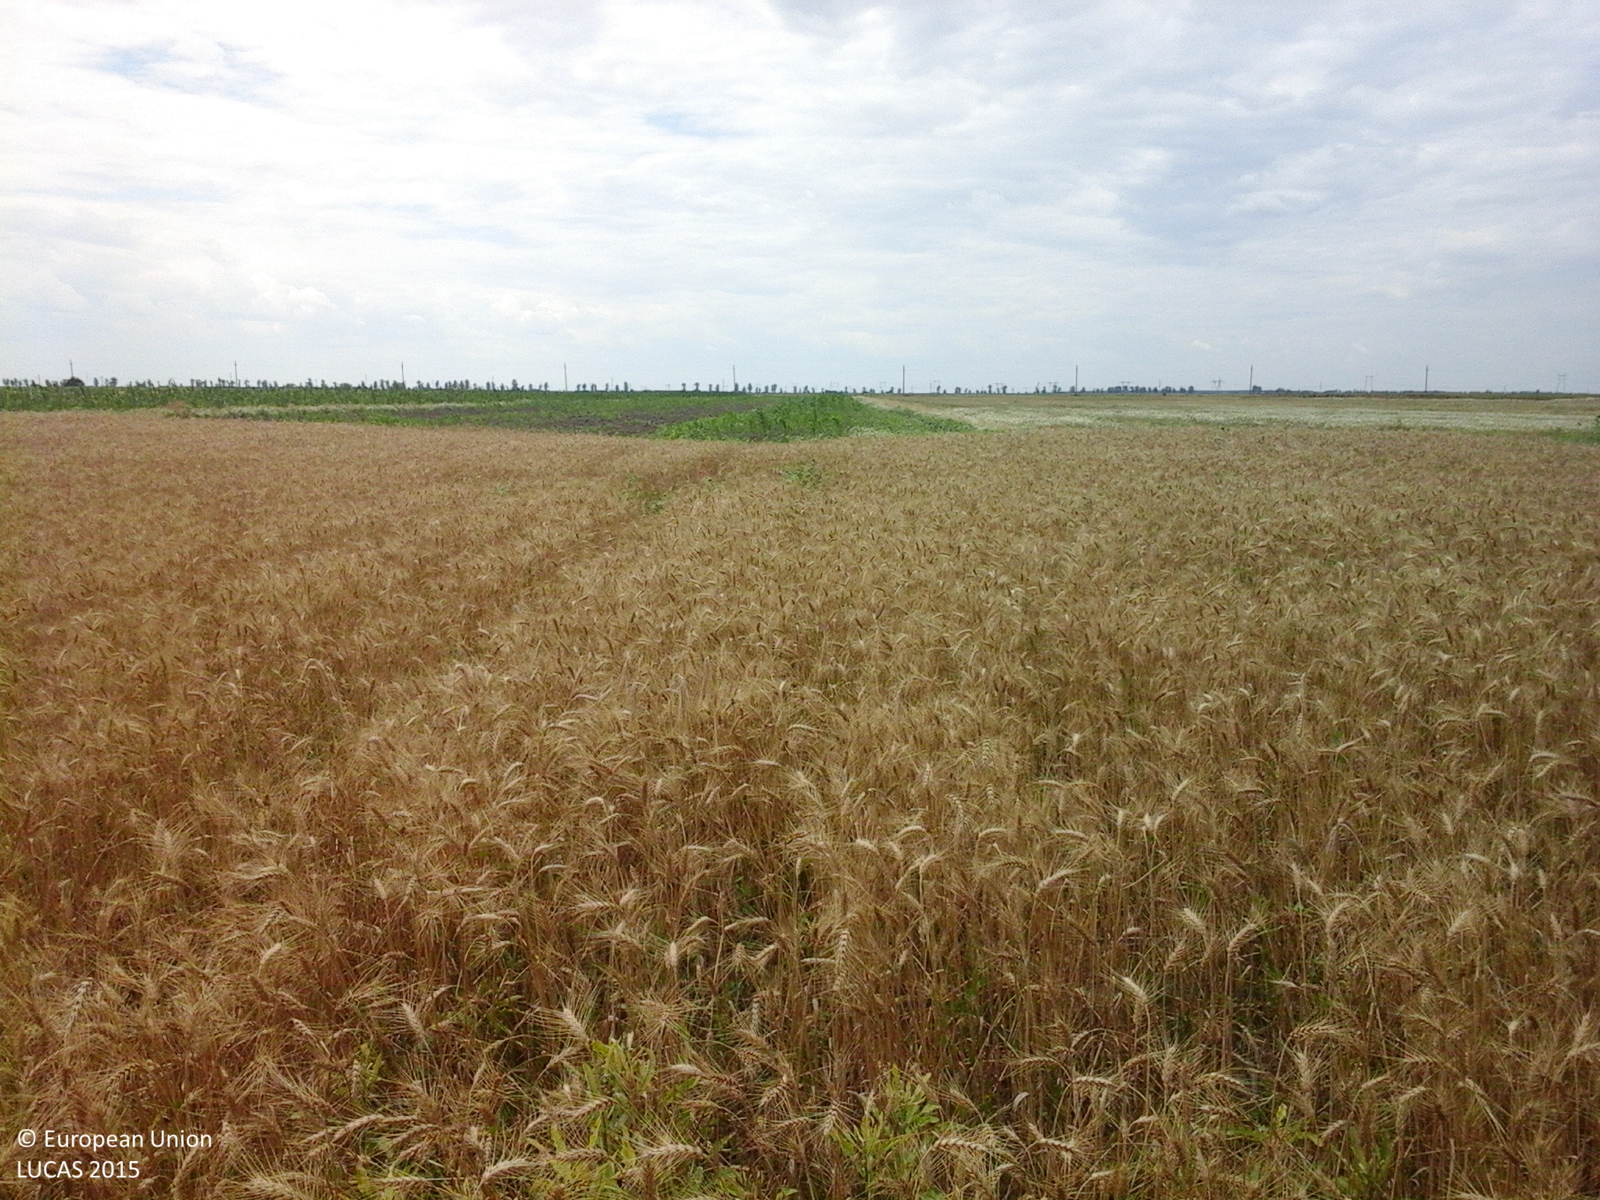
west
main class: Cropland
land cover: Common wheat
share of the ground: > 75 %
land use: Agriculture (excluding fallow land and kitchen gardens)
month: July
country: RO
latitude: 44.2331
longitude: 25.5525
